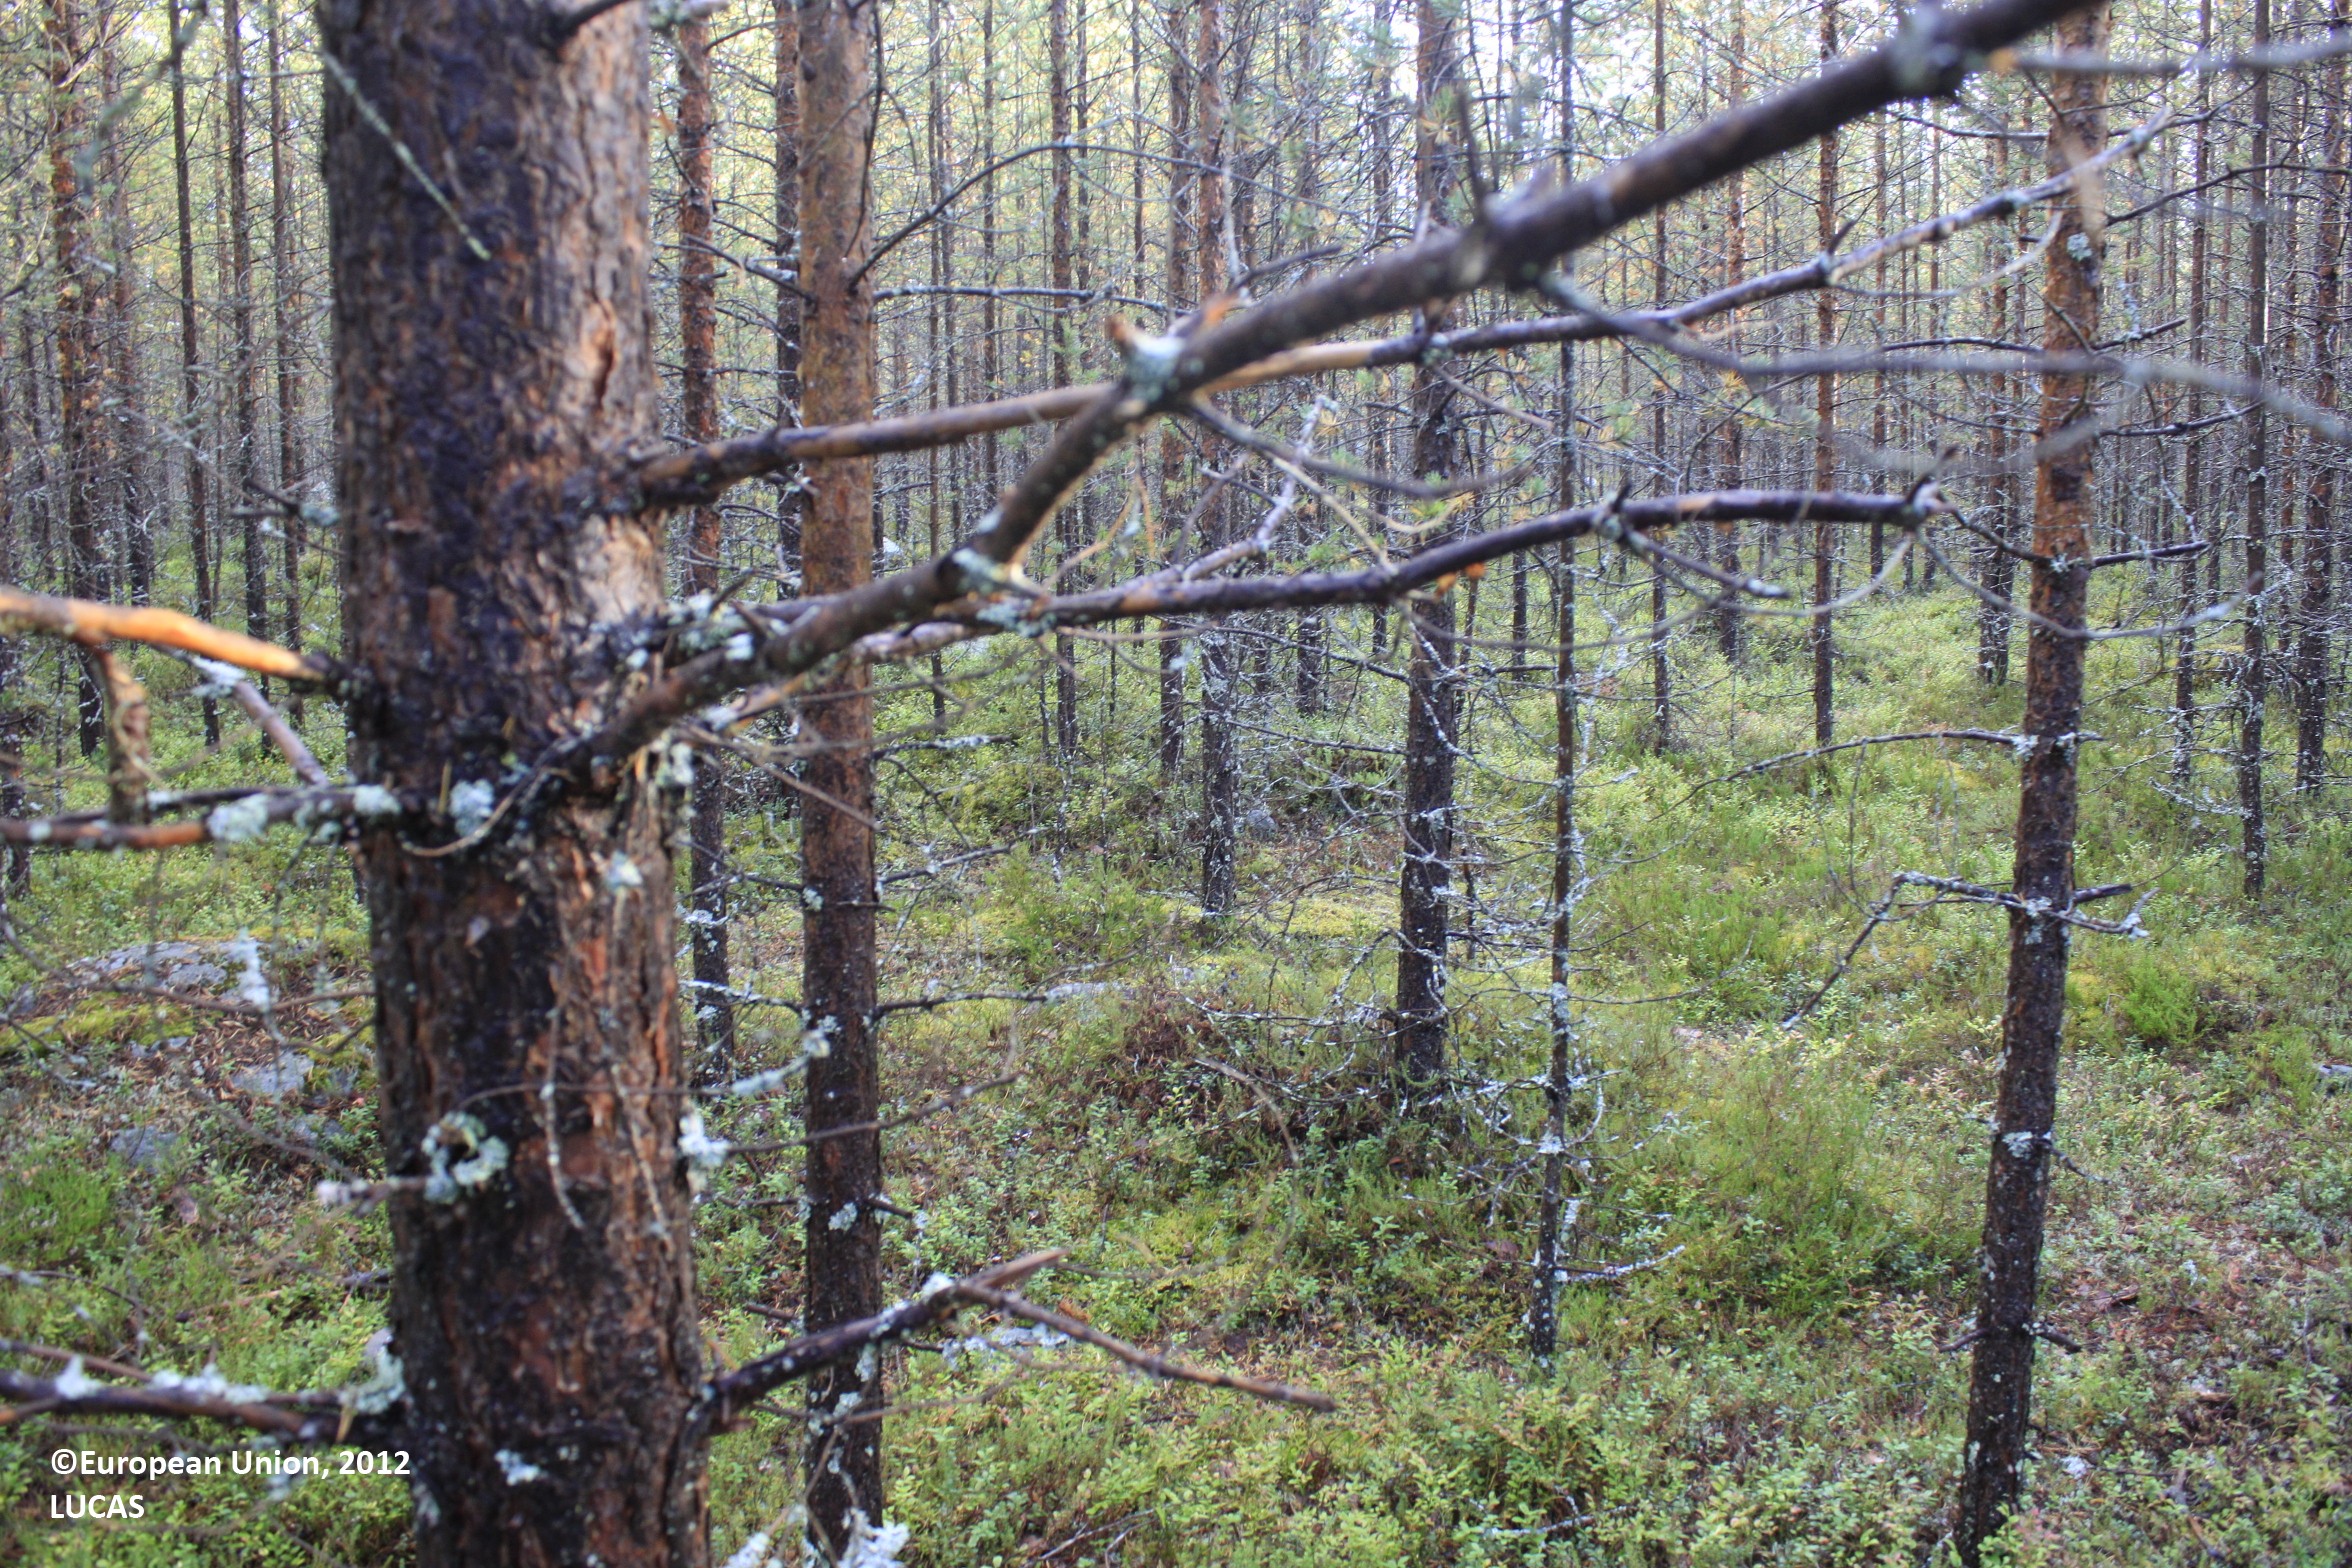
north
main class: Woodland
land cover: Pine dominated coniferous woodland
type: boreal forest
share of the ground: 50 - 75 %
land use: Forestry
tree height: > 5 m
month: September
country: FI
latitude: 65.2621
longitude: 26.9282
